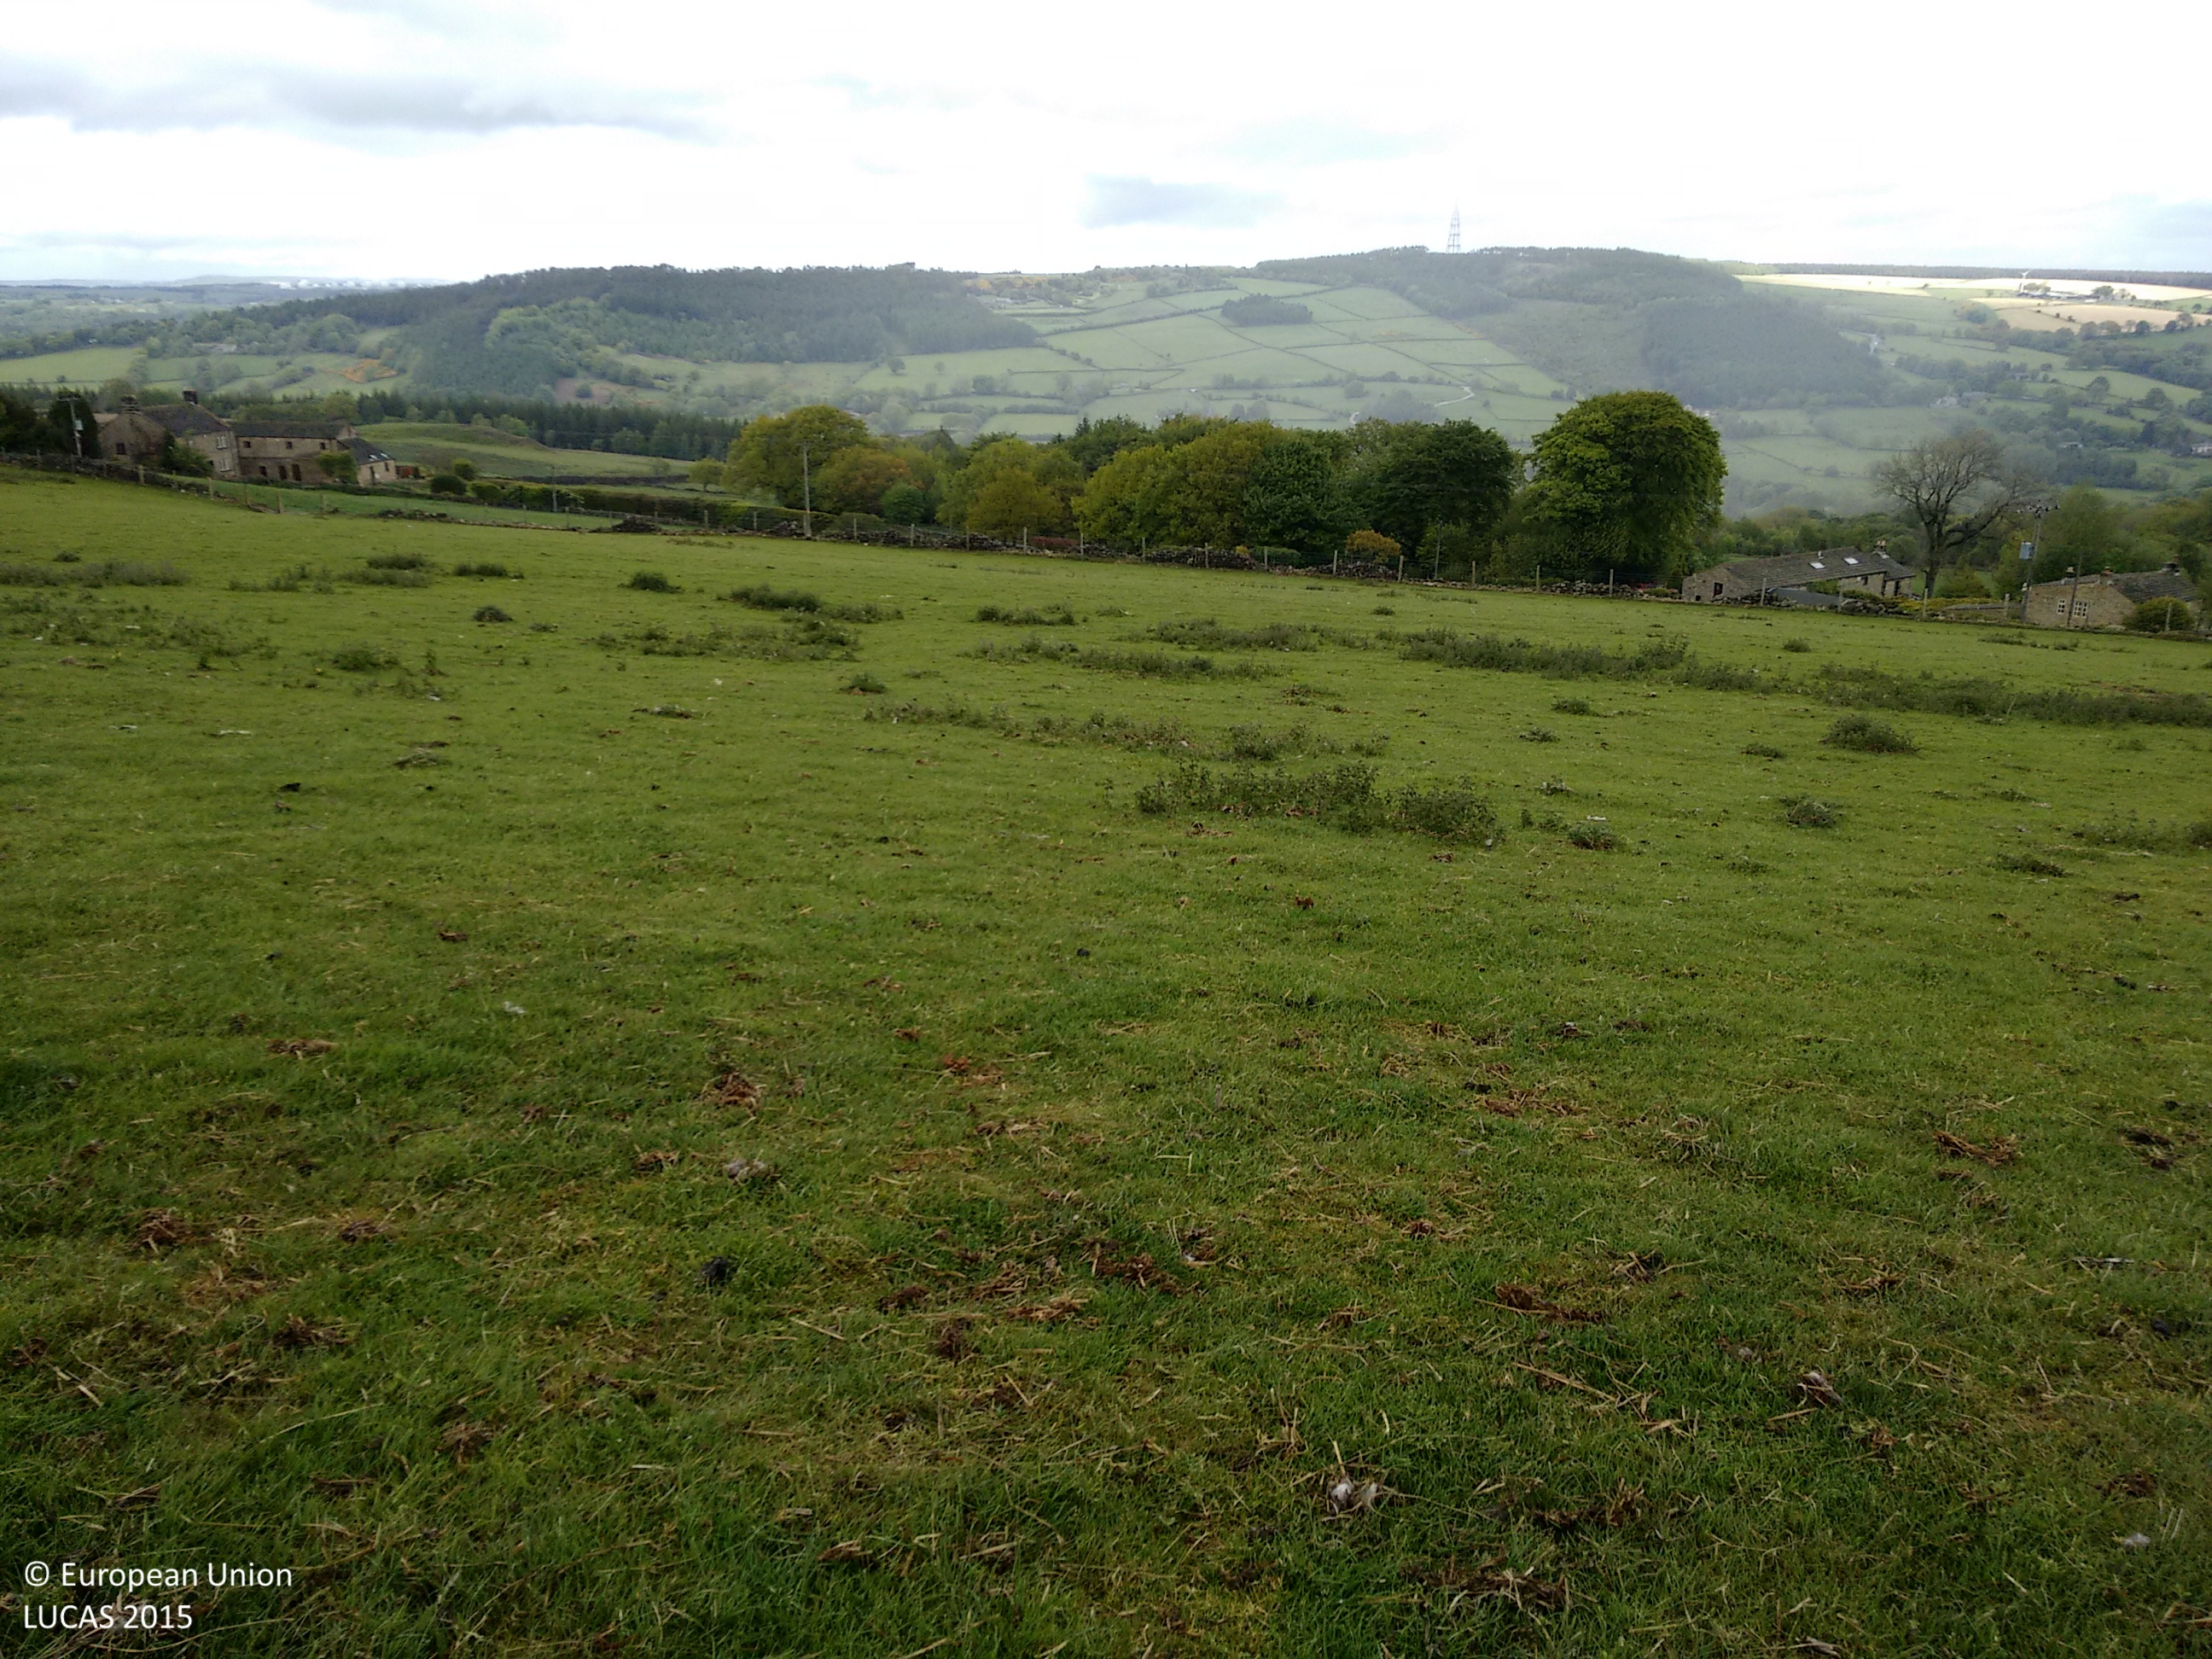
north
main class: Grassland
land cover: Grassland without tree/shrub cover
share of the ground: > 75 %
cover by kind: herbaceous plants 100 %
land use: Agriculture (excluding fallow land and kitchen gardens)
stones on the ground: < 10 %
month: May
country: GB
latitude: 53.9406
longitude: -1.7064
